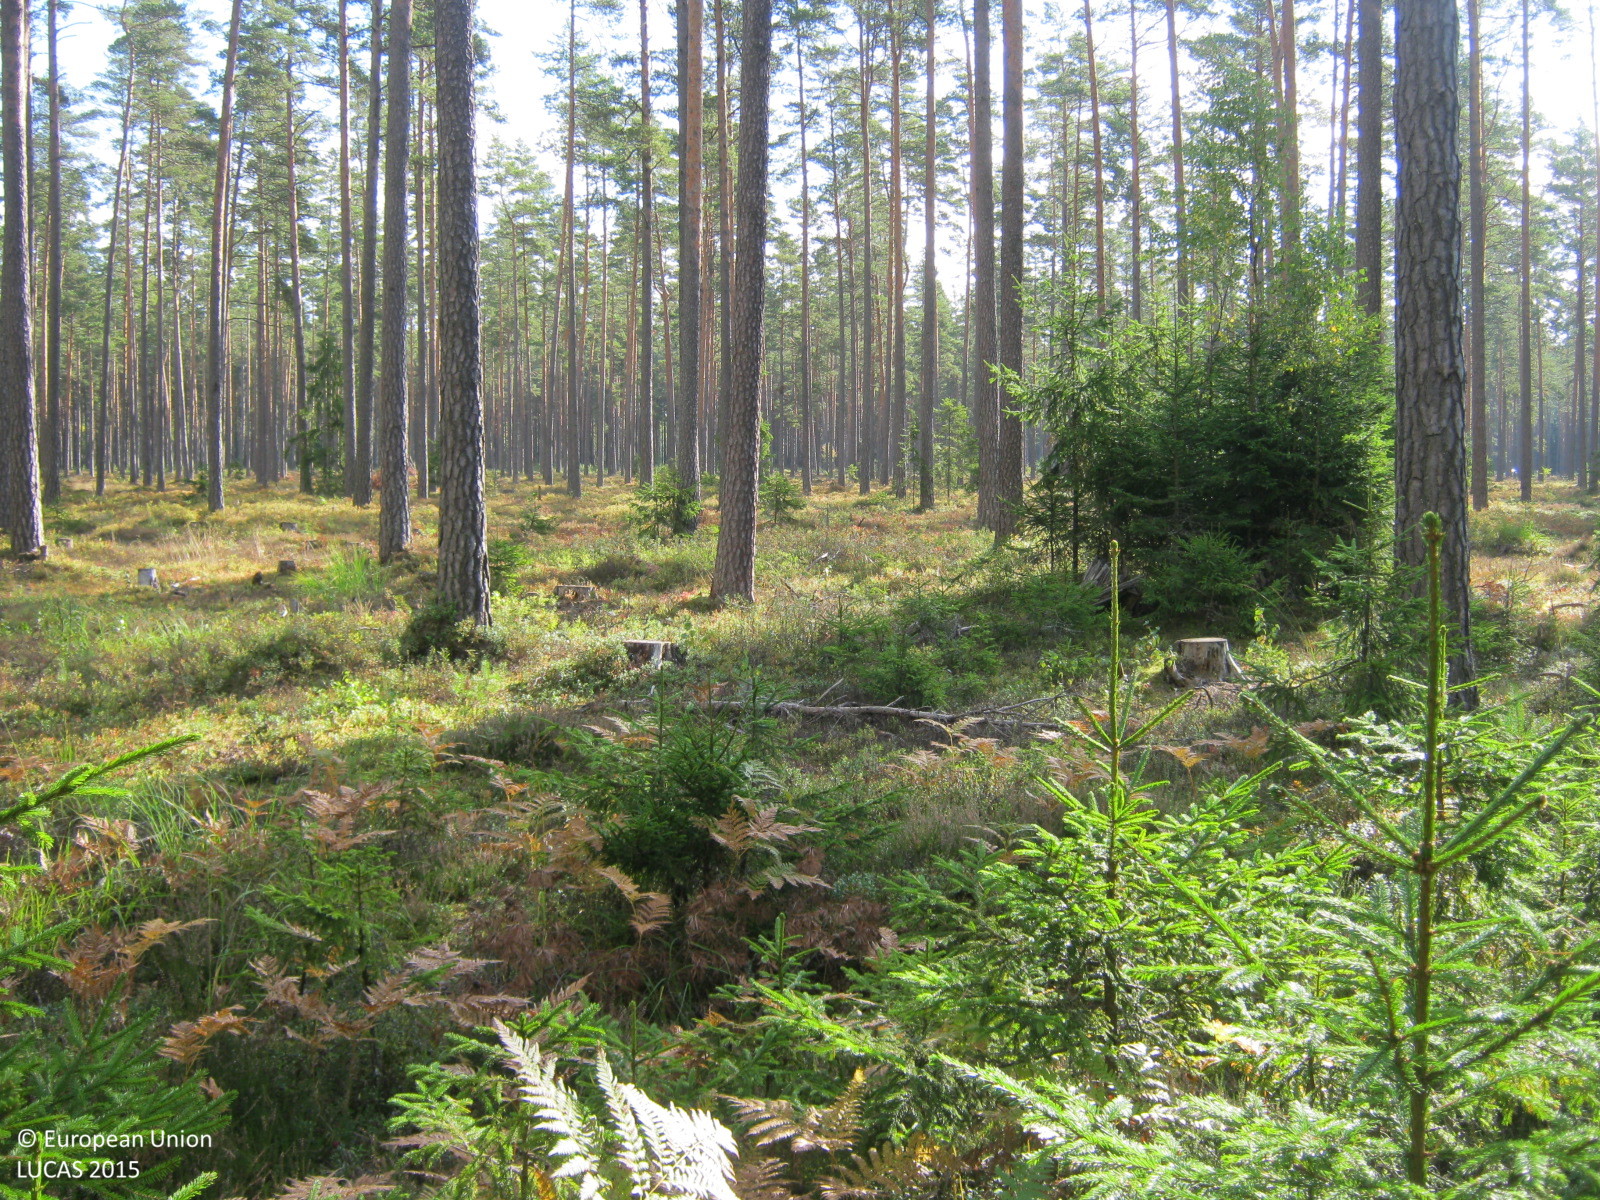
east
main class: Woodland
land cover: Other coniferous woodland
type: hemiboreal forest and nemoral coniferous forest and mixed broadleaved-coniferous forest
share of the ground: > 75 %
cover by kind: coniferous forest trees 80 %, shrubs 10 %, lichens and mosses 10 %
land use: Forestry
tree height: > 5 m
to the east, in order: Other coniferous woodland; Pine dominated coniferous woodland; Tracks; Pine dominated coniferous woodland
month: September
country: LV
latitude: 57.3045
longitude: 24.4487
